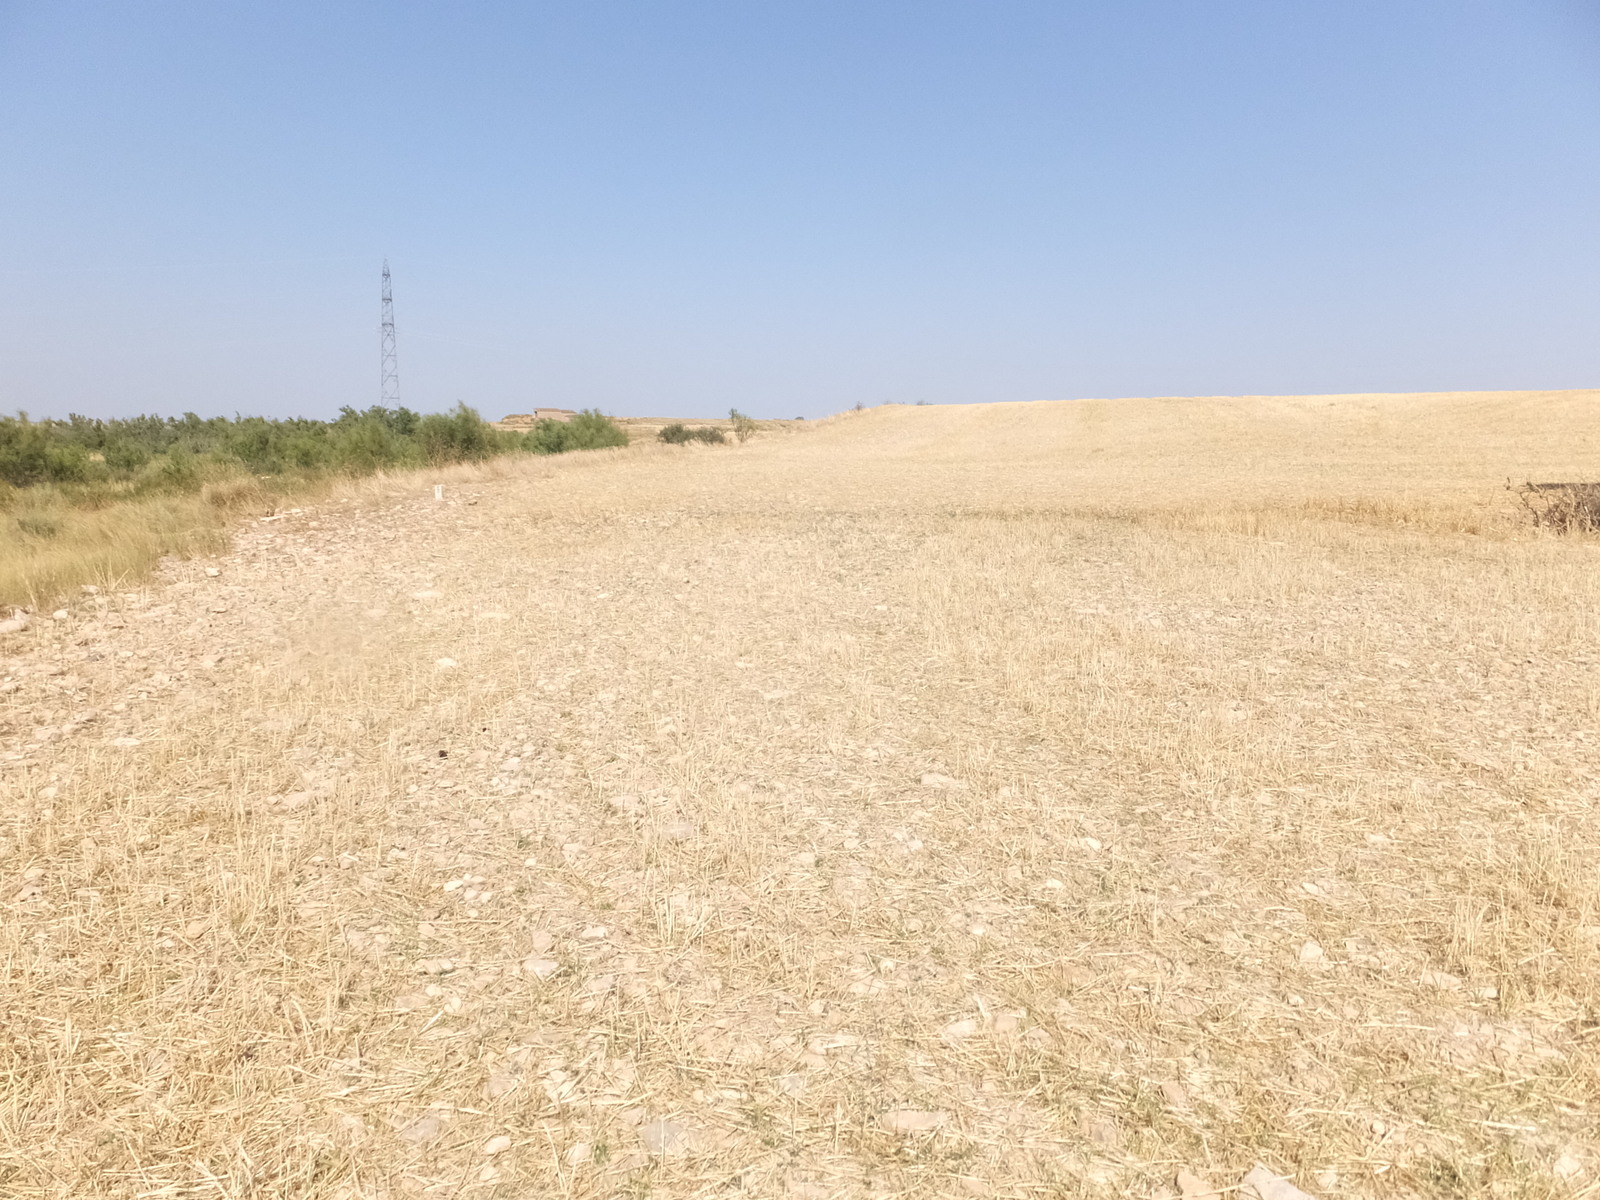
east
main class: Cropland
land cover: Barley
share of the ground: < 10 %
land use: Agriculture (excluding fallow land and kitchen gardens)
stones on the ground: < 10 %
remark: Harvested field
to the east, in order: Barley; Shrubland with sparse tree cover; Barley; Single bushes/trees; Barley; Shruby margins; Barley
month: July
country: ES
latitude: 41.5740
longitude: 0.1633
